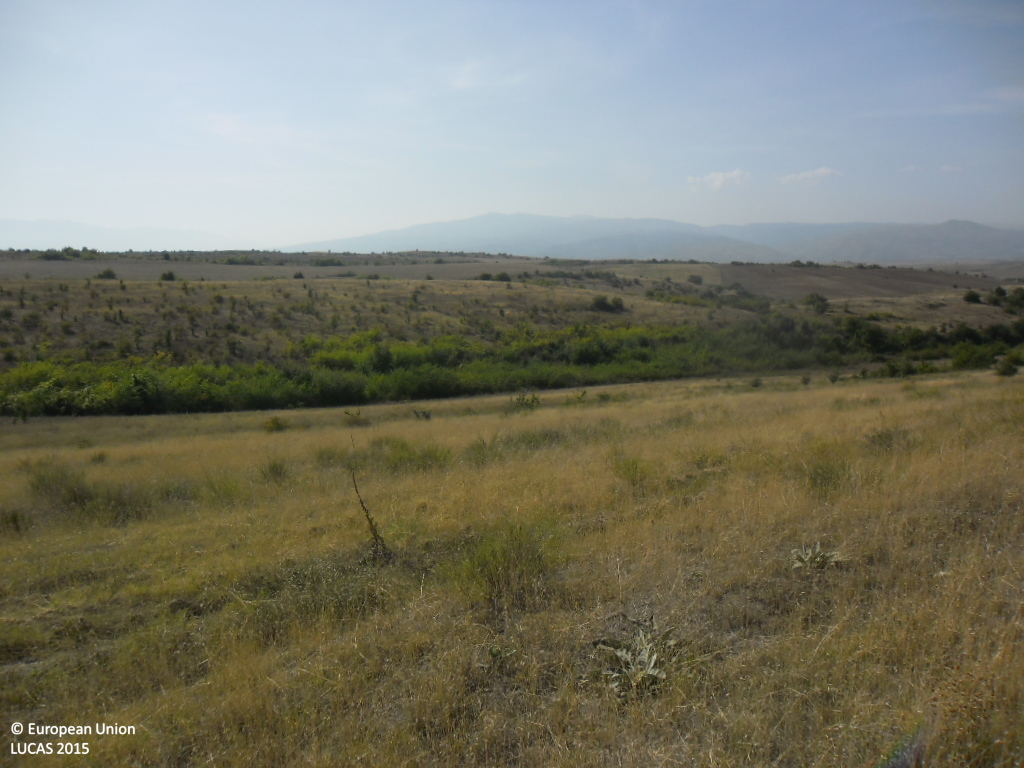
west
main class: Grassland
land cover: Spontaneously vegetated surfaces
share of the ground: 25 - 50 %
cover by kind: herbaceous plants 90 %, unconsolidated bare surface 10 %
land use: Agriculture (excluding fallow land and kitchen gardens)
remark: Harvested field
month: September
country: BG
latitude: 41.4911
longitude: 23.3534
